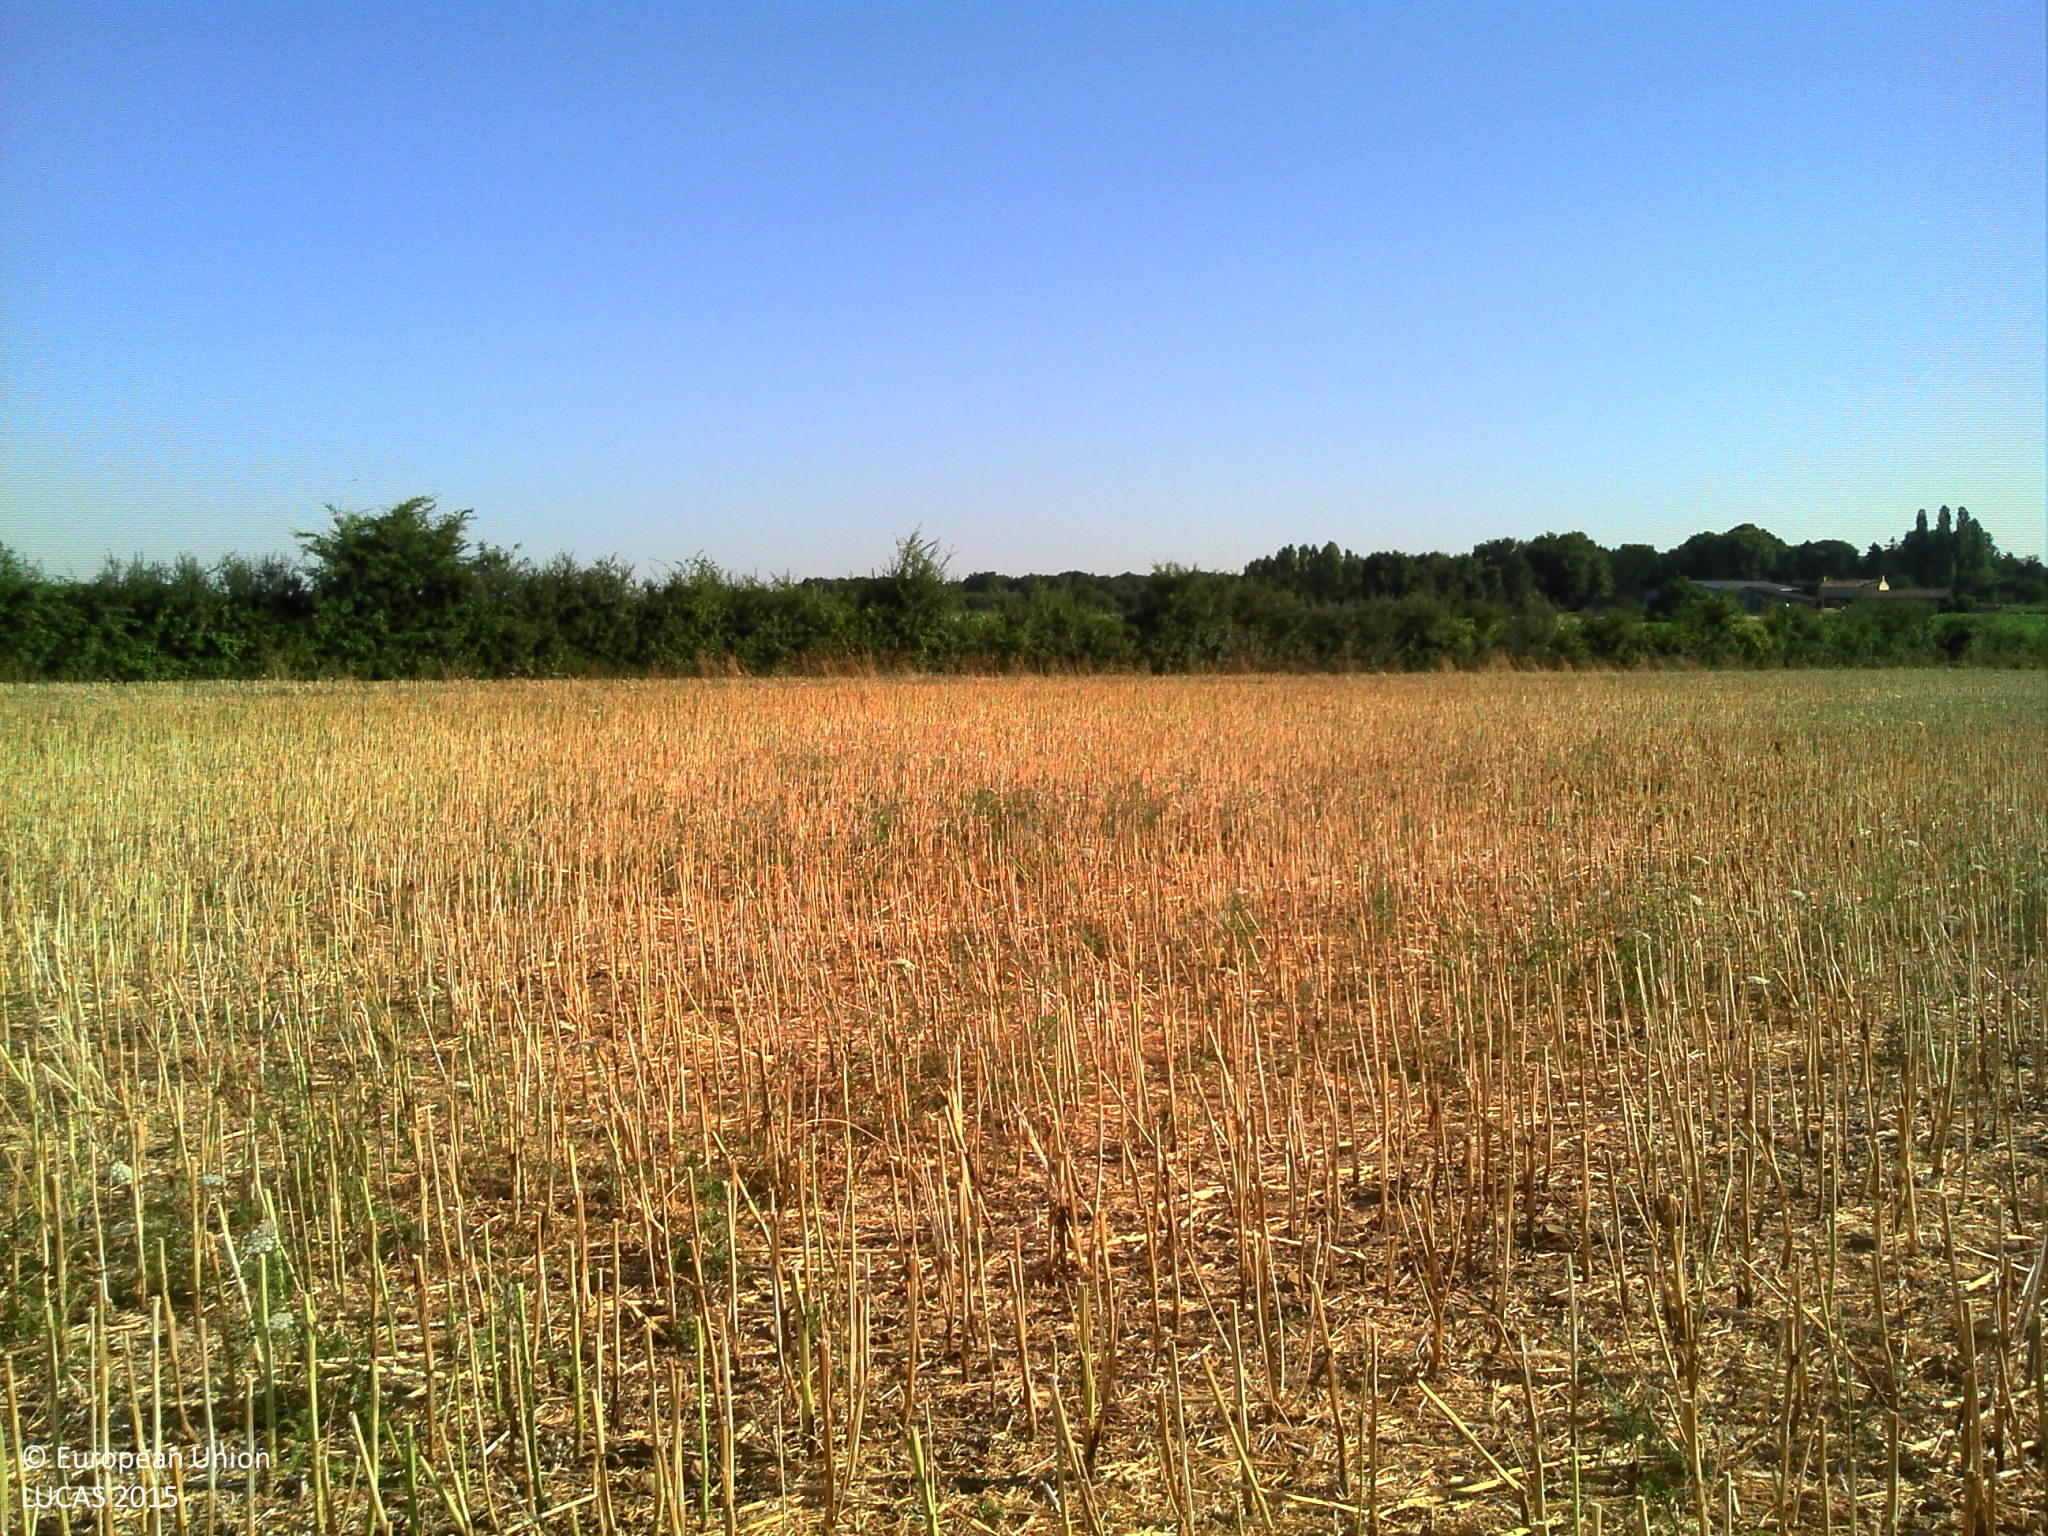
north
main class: Cropland
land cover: Rape and turnip rape
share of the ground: < 10 %
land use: Agriculture (excluding fallow land and kitchen gardens)
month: July
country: FR
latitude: 46.5386
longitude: 0.2397
